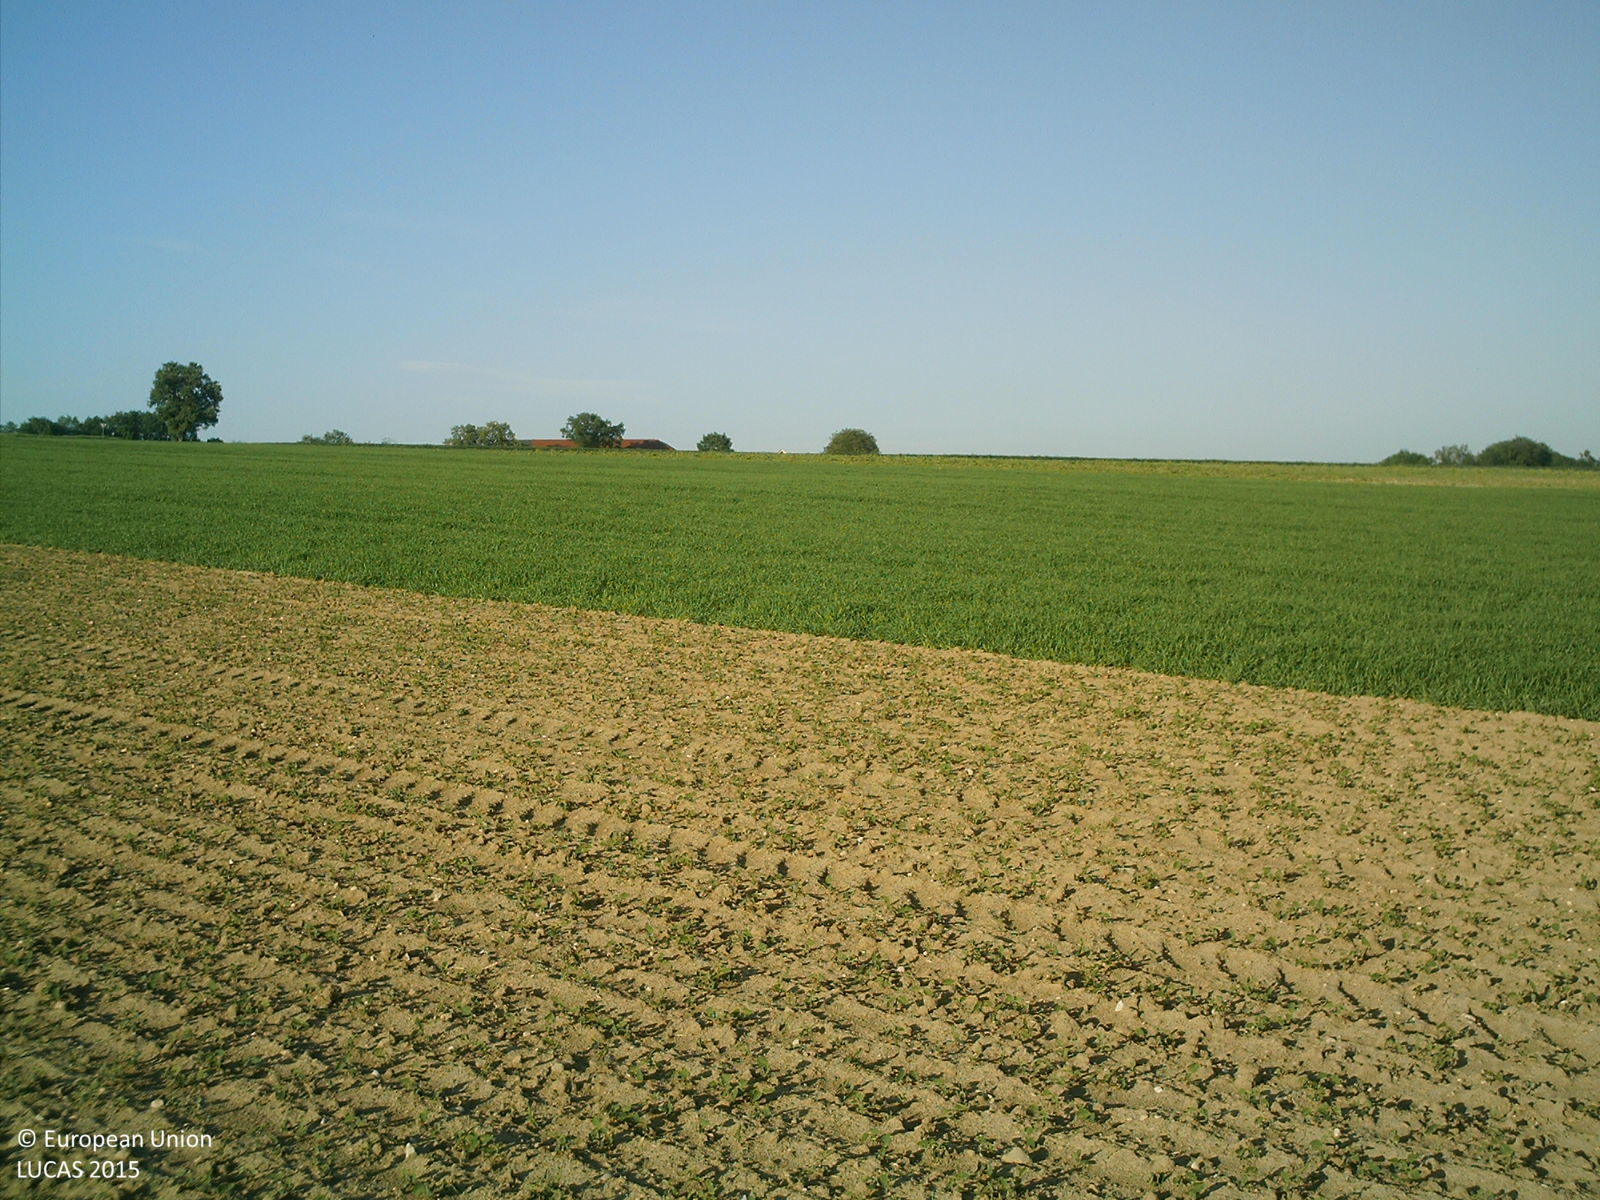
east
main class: Cropland
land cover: Soya
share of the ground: 50 - 75 %
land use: Agriculture (excluding fallow land and kitchen gardens)
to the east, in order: Soya; Temporary grasslands; Maize
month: May
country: AT
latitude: 48.0196
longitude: 14.1425
